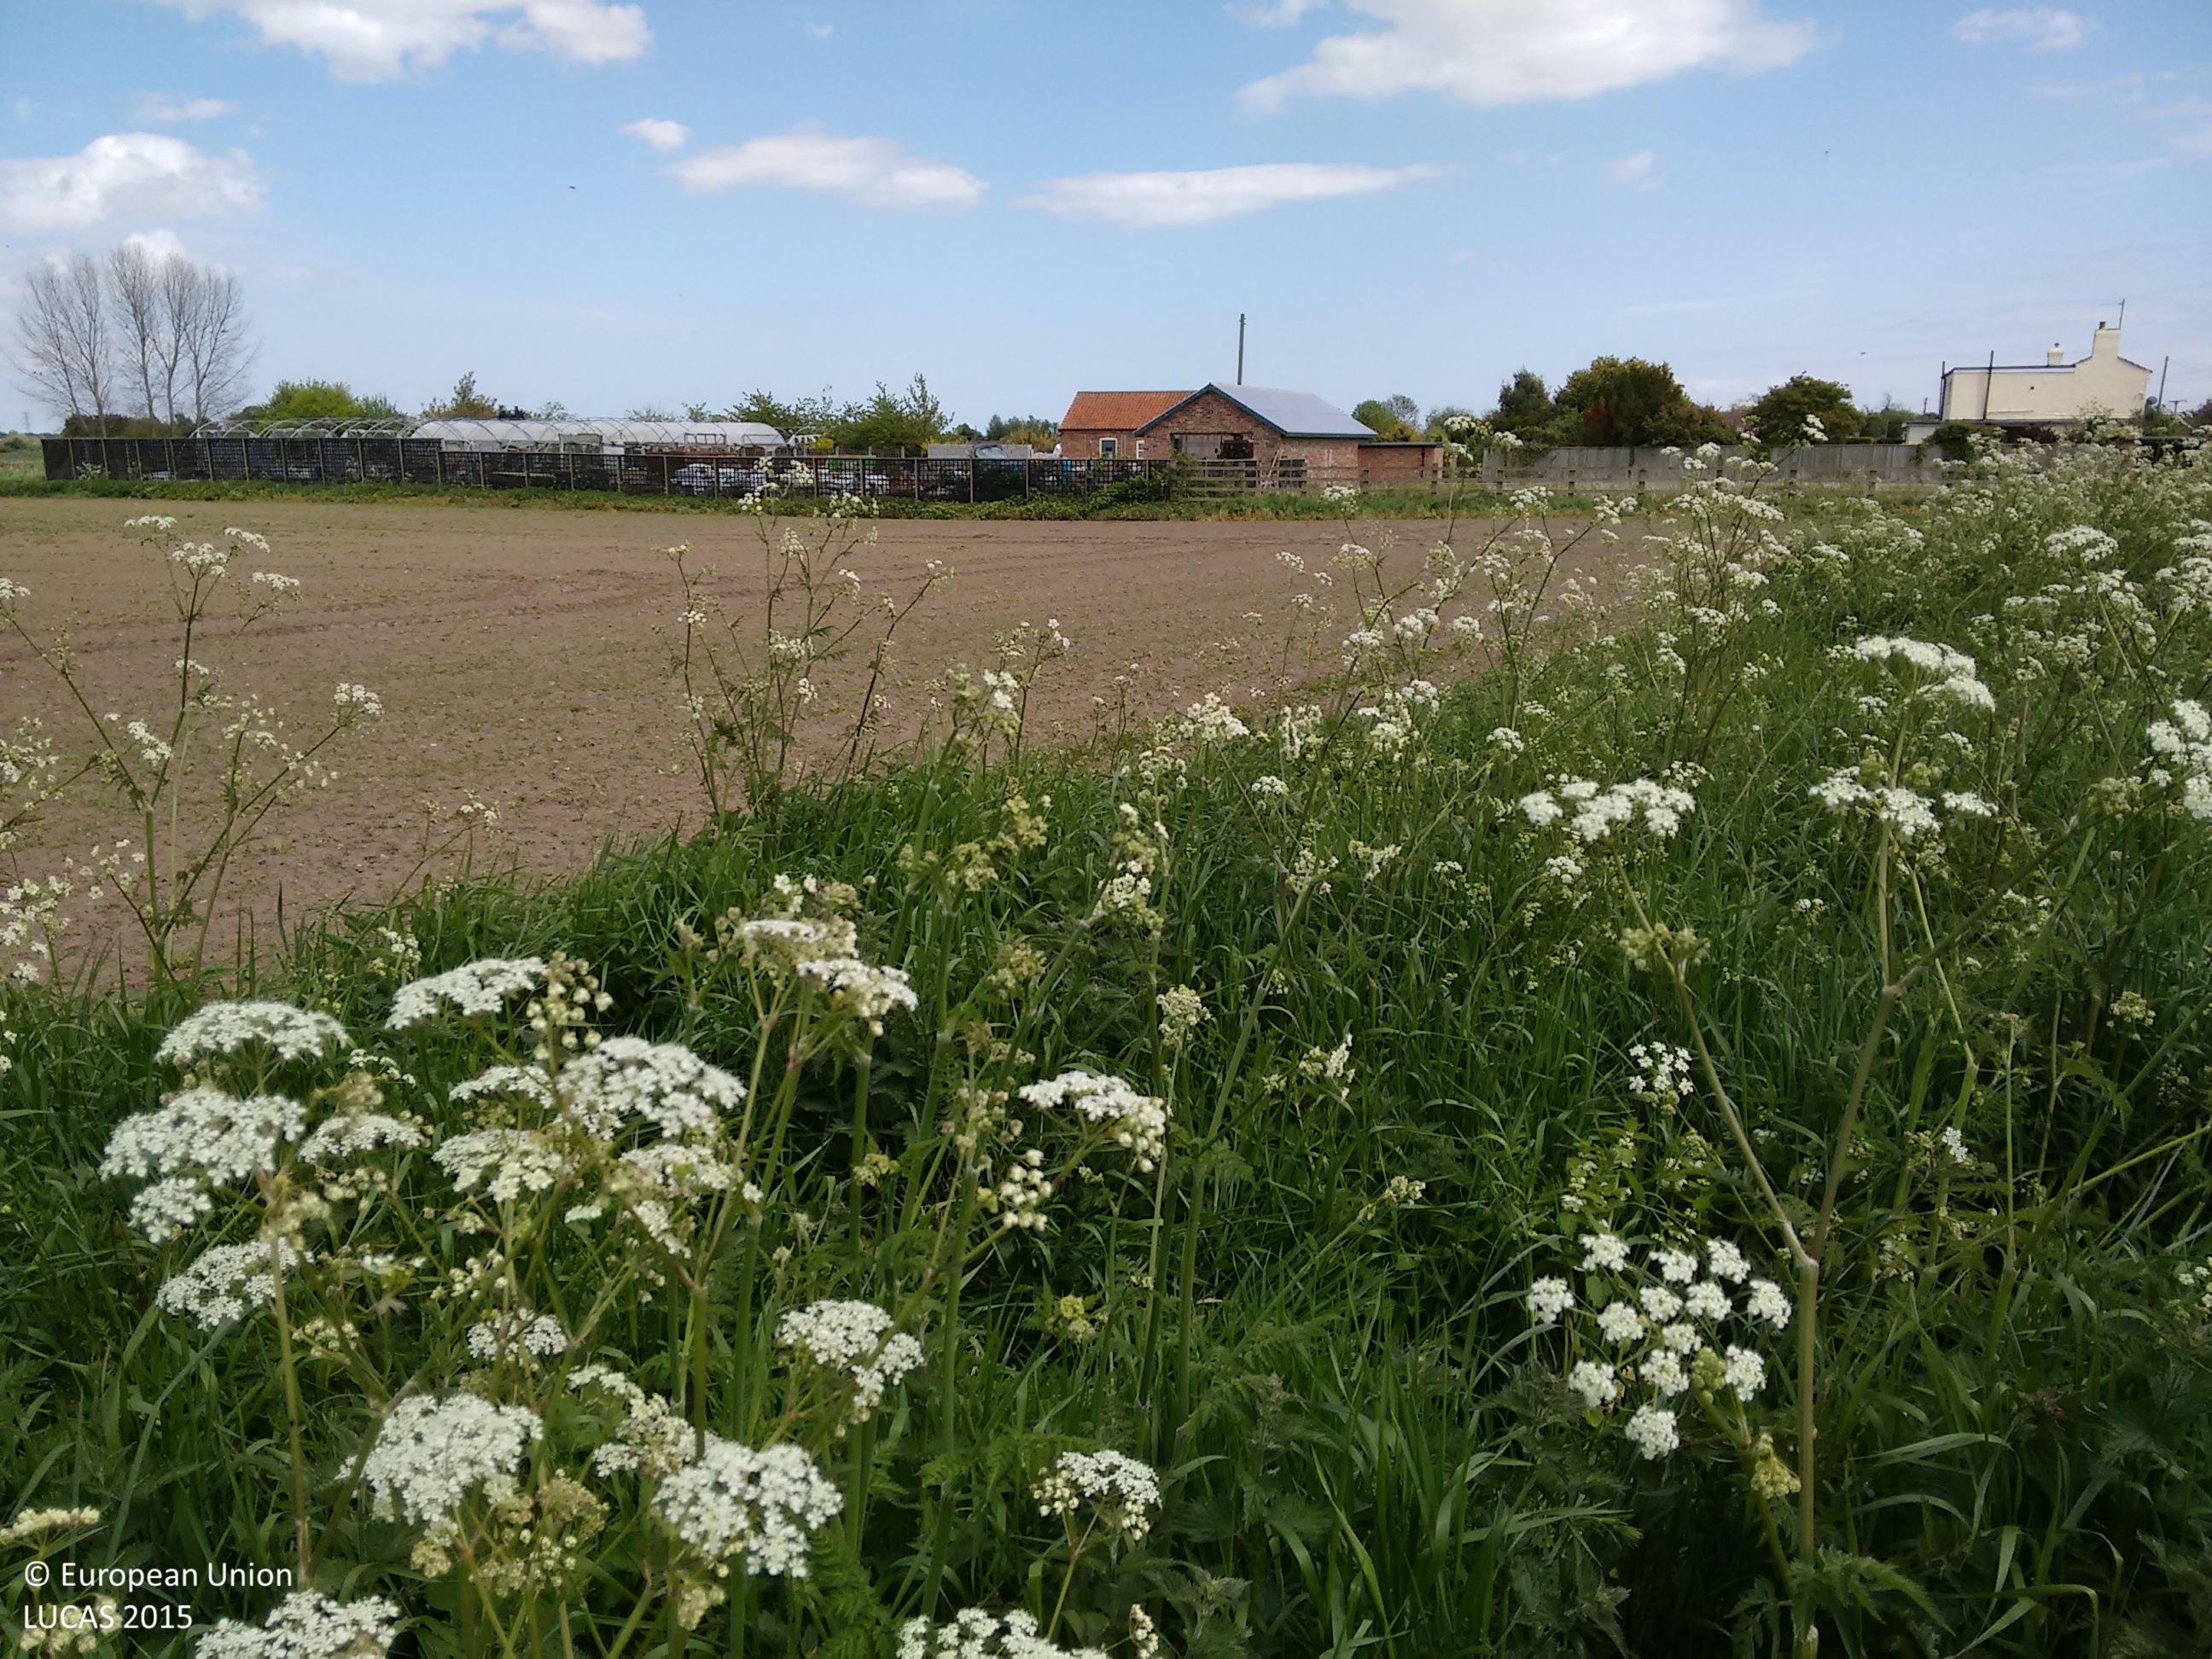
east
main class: Grassland
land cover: Grassland without tree/shrub cover
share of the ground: > 75 %
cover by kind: herbaceous plants 100 %
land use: Agriculture (excluding fallow land and kitchen gardens)
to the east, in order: Grassland without tree/shrub cover; Other fresh vegetables; Grass margins; Artificial constructions in urban areas; Grassland without tree/shrub cover
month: May
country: GB
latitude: 52.9442
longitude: -0.0780
